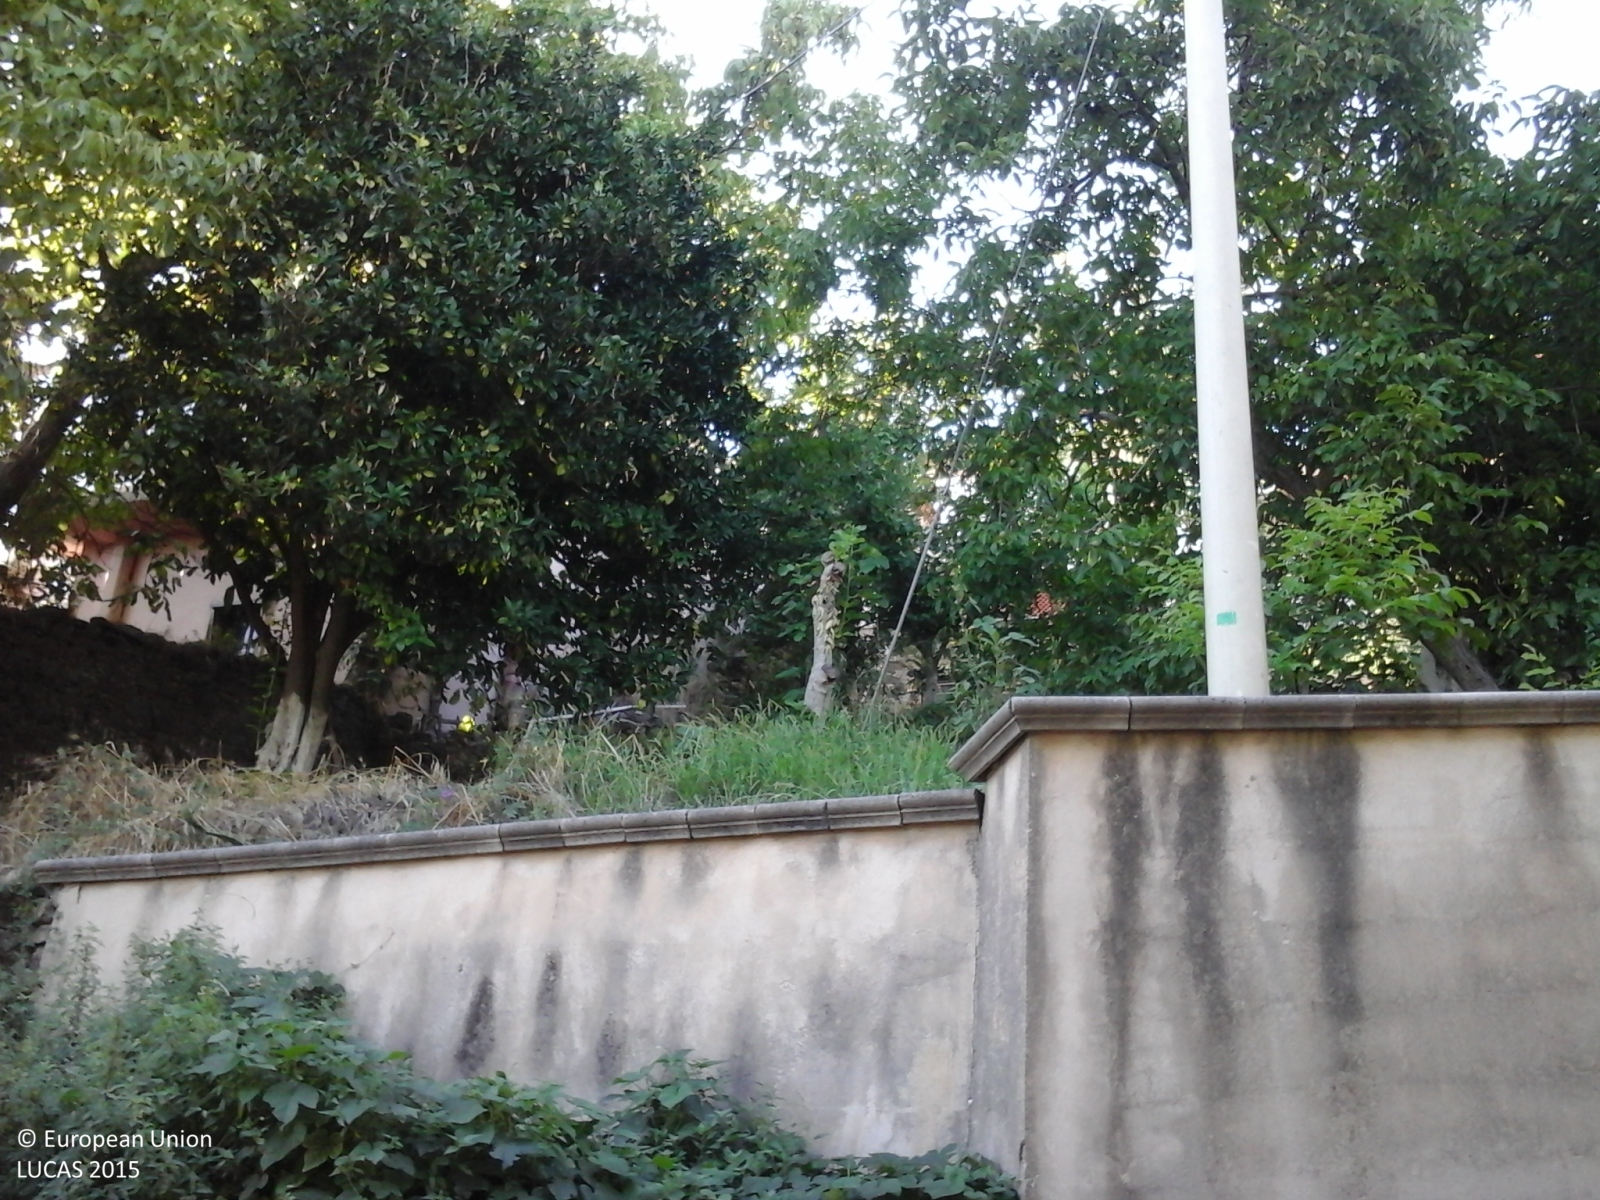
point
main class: Cropland
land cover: Other fruit trees and berries
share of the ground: > 75 %
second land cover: Spontaneously vegetated surfaces
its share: > 75 %
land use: Kitchen garden
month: August
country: IT
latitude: 40.2993
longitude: 15.0718
